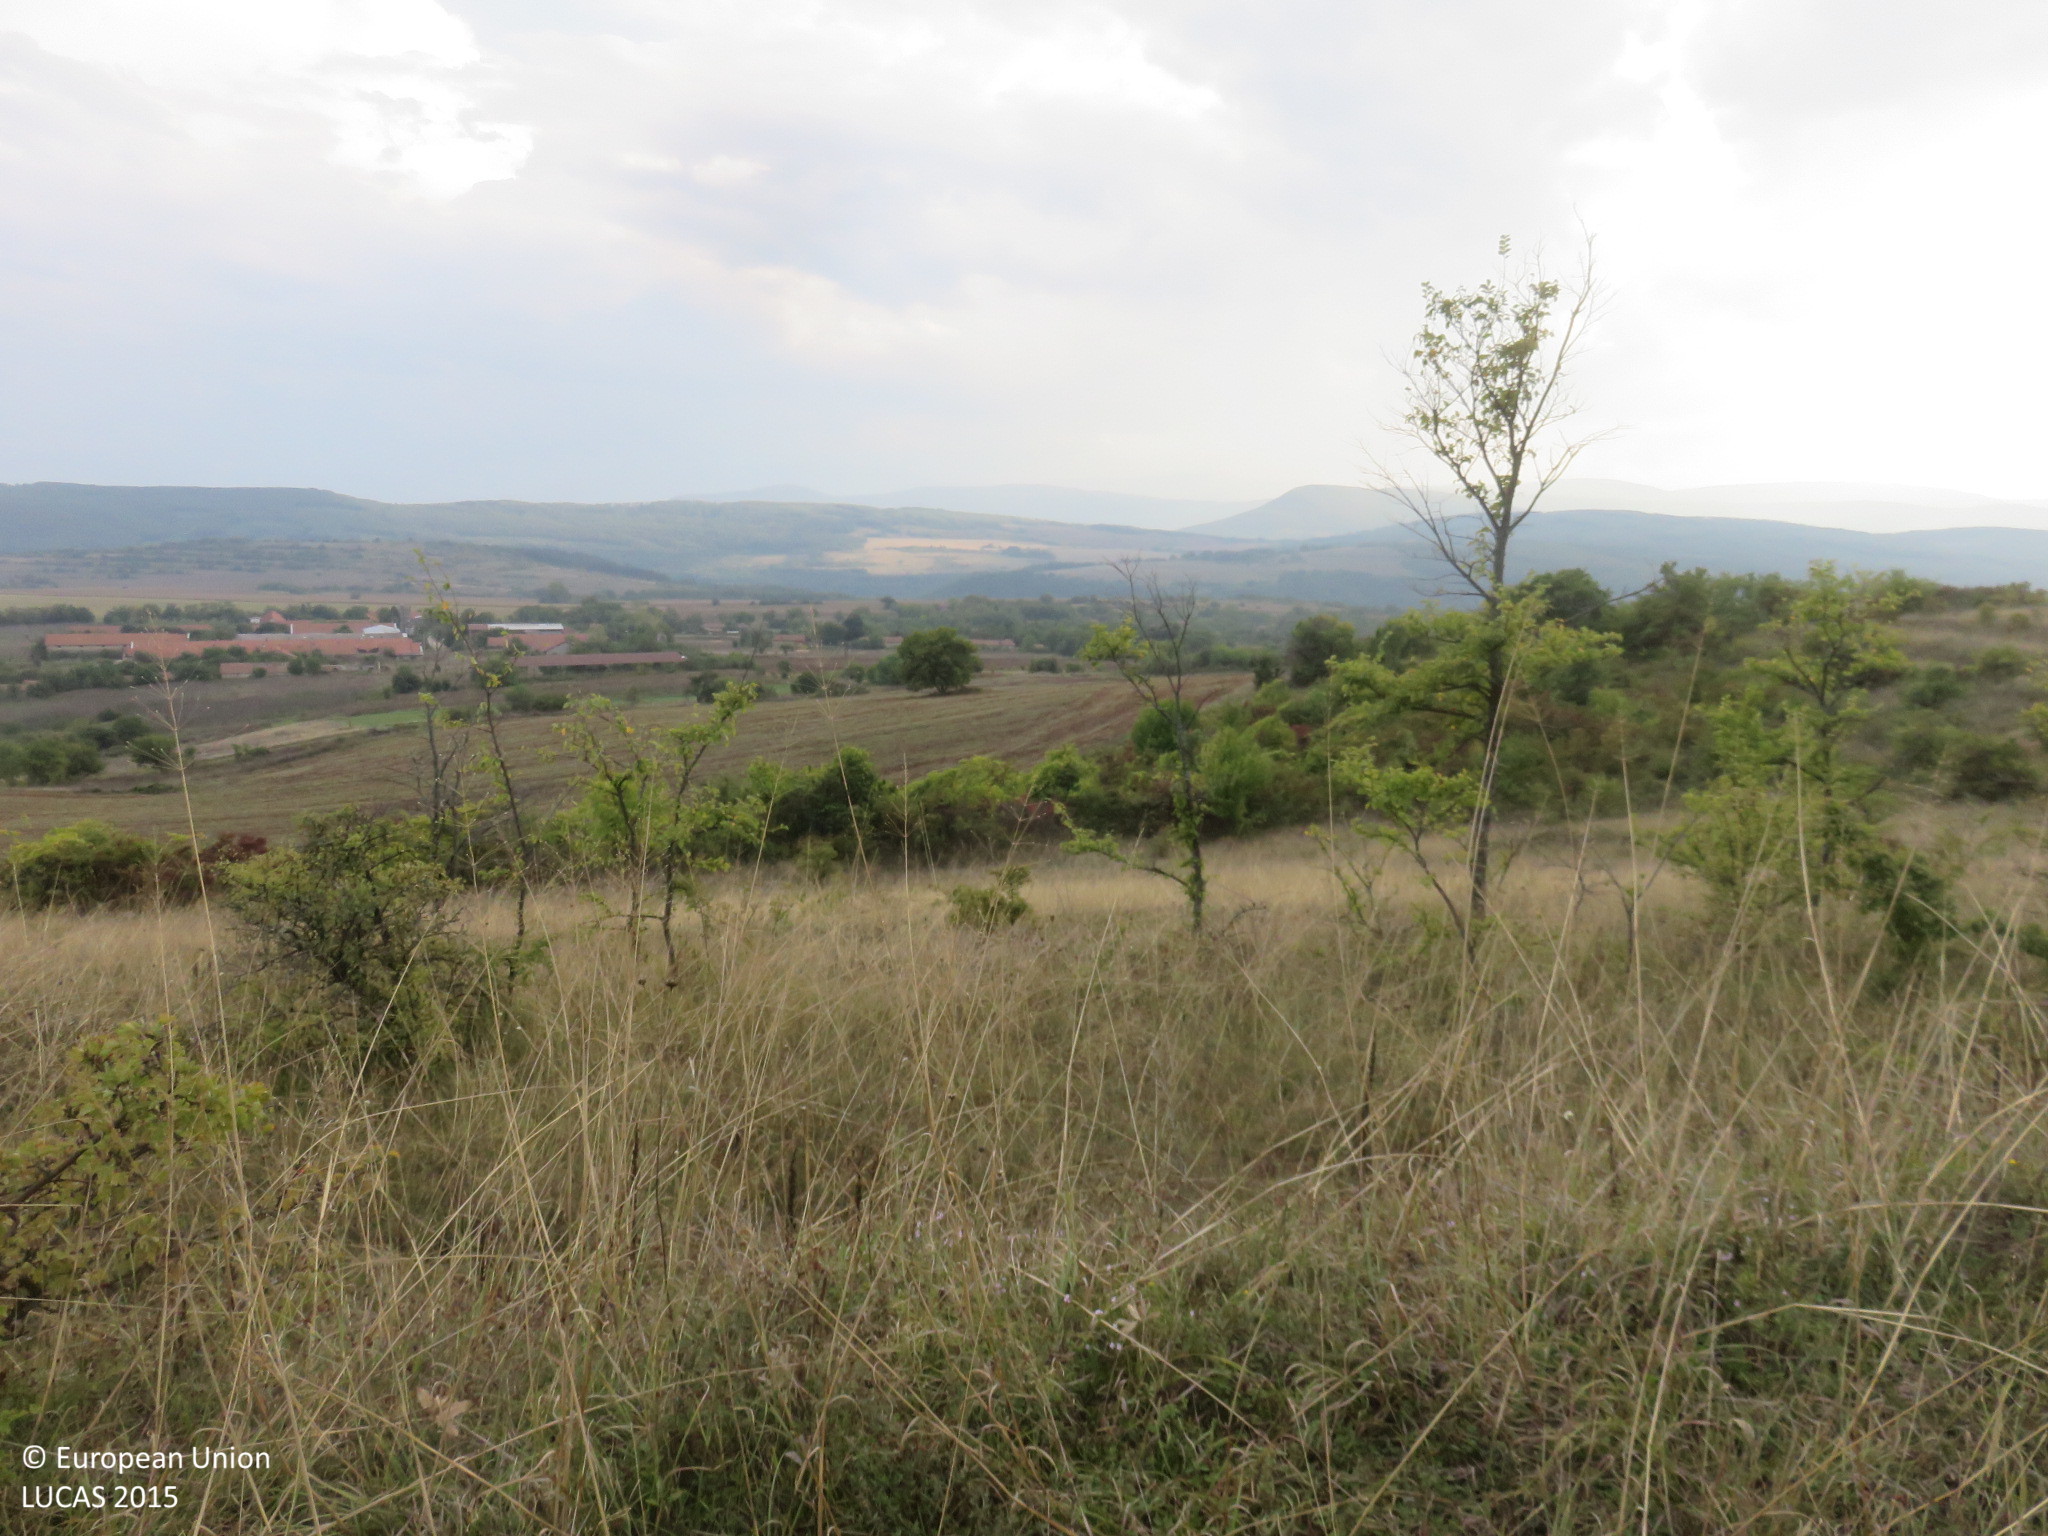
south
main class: Grassland
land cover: Grassland with sparse tree/shrub cover
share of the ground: > 75 %
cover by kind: herbaceous plants 90 %, broadleaved forest trees 5 %, shrubs 5 %
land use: Semi-natural and natural areas not in use
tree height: < 5 m
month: September
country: BG
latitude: 43.1032
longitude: 25.0210
